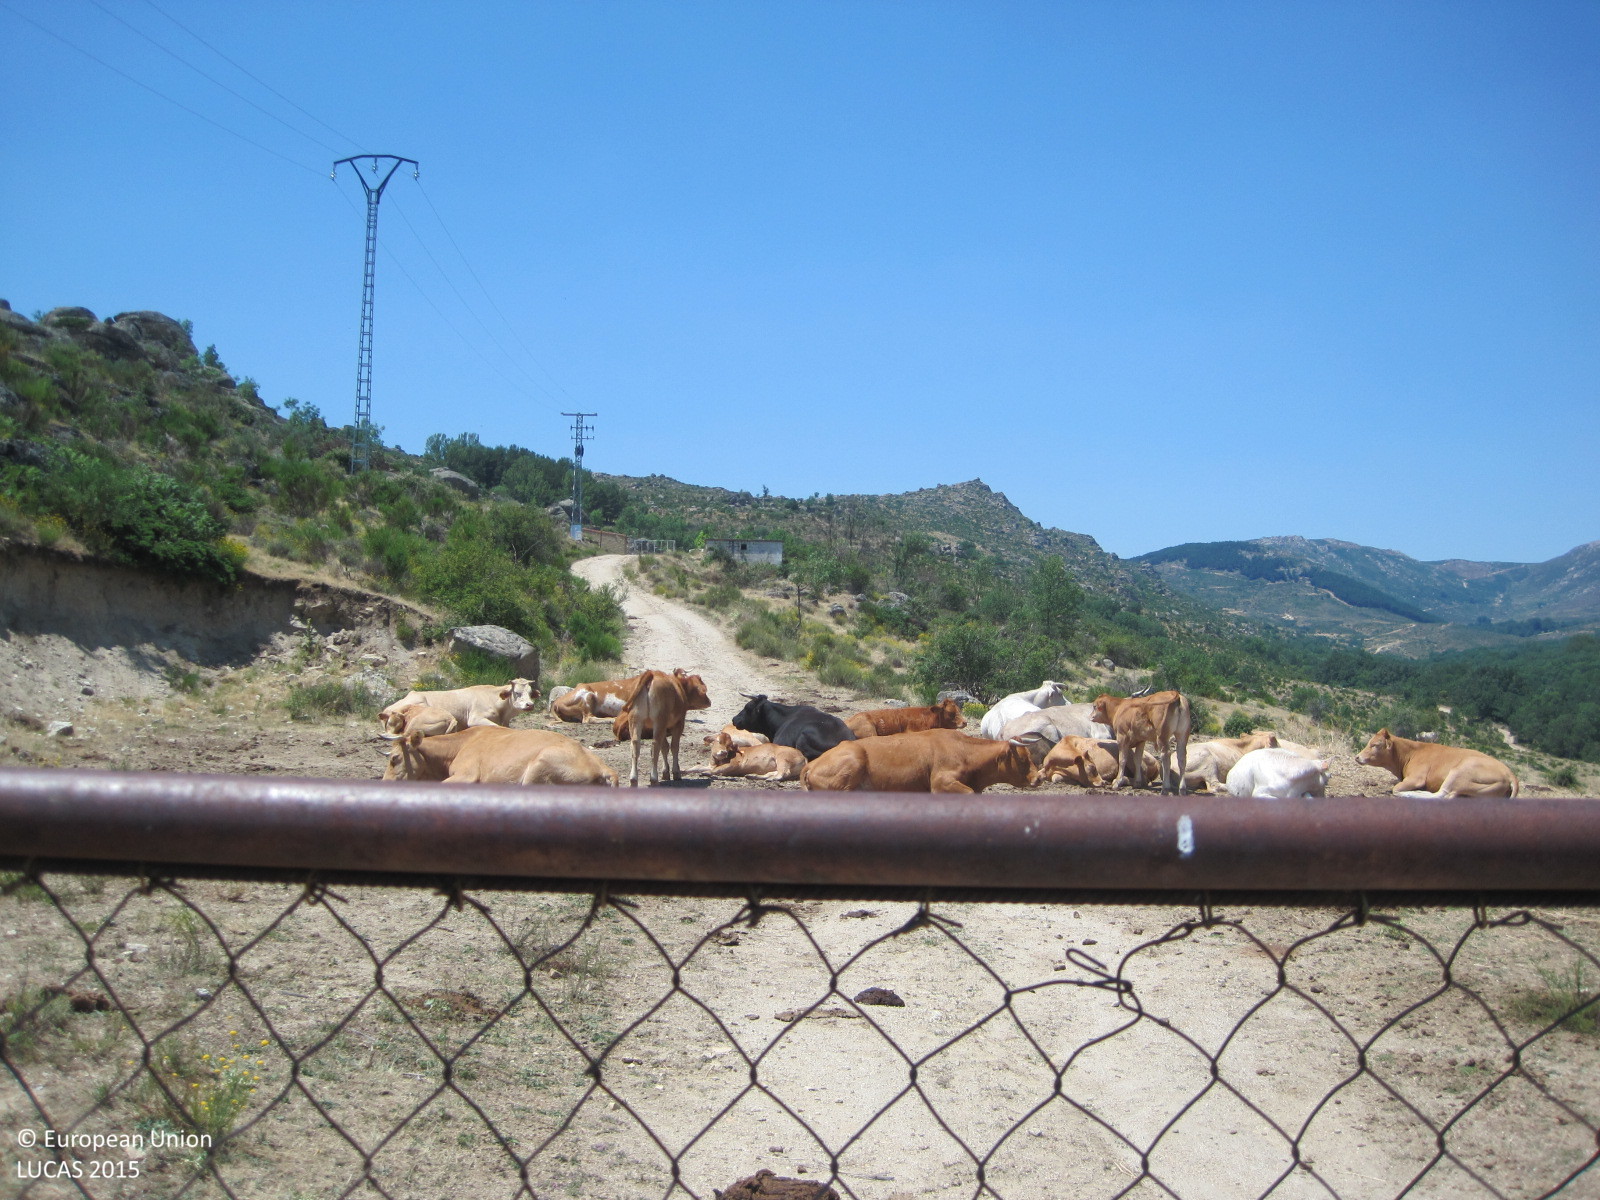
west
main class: Woodland
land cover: Pine dominated coniferous woodland
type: coniferous forest of the mediterranean region
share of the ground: > 75 %
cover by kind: coniferous forest trees 95 %, herbaceous plants 5 %
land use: Forestry
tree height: > 5 m
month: June
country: ES
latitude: 40.4478
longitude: -4.8764
